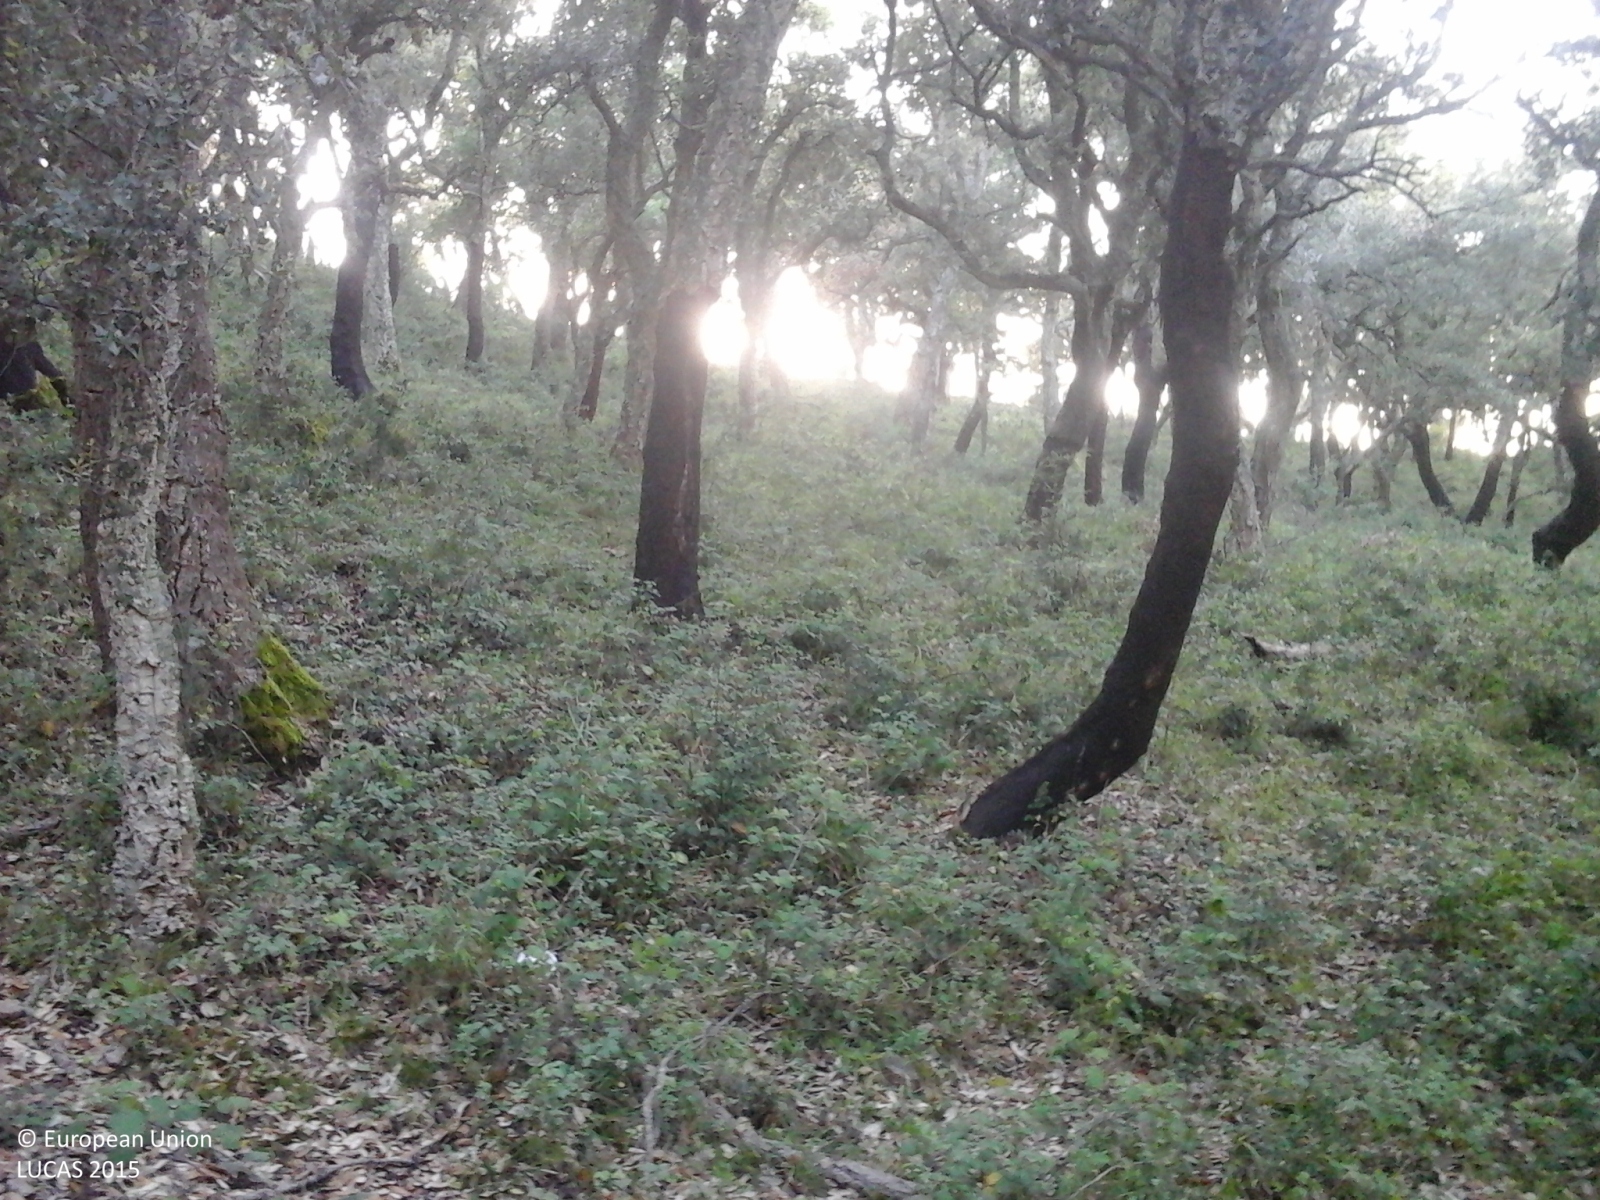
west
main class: Woodland
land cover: Broadleaved woodland
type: broadleaved evergreen forest
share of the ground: > 75 %
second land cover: Grassland without tree/shrub cover
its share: > 75 %
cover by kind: broadleaved forest trees 80 %, shrubs 10 %, herbaceous plants 5 %, consolidated bare surface 5 %
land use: Forestry
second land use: Agriculture (excluding fallow land and kitchen gardens)
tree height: > 5 m
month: May
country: IT
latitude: 37.8934
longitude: 14.1442
